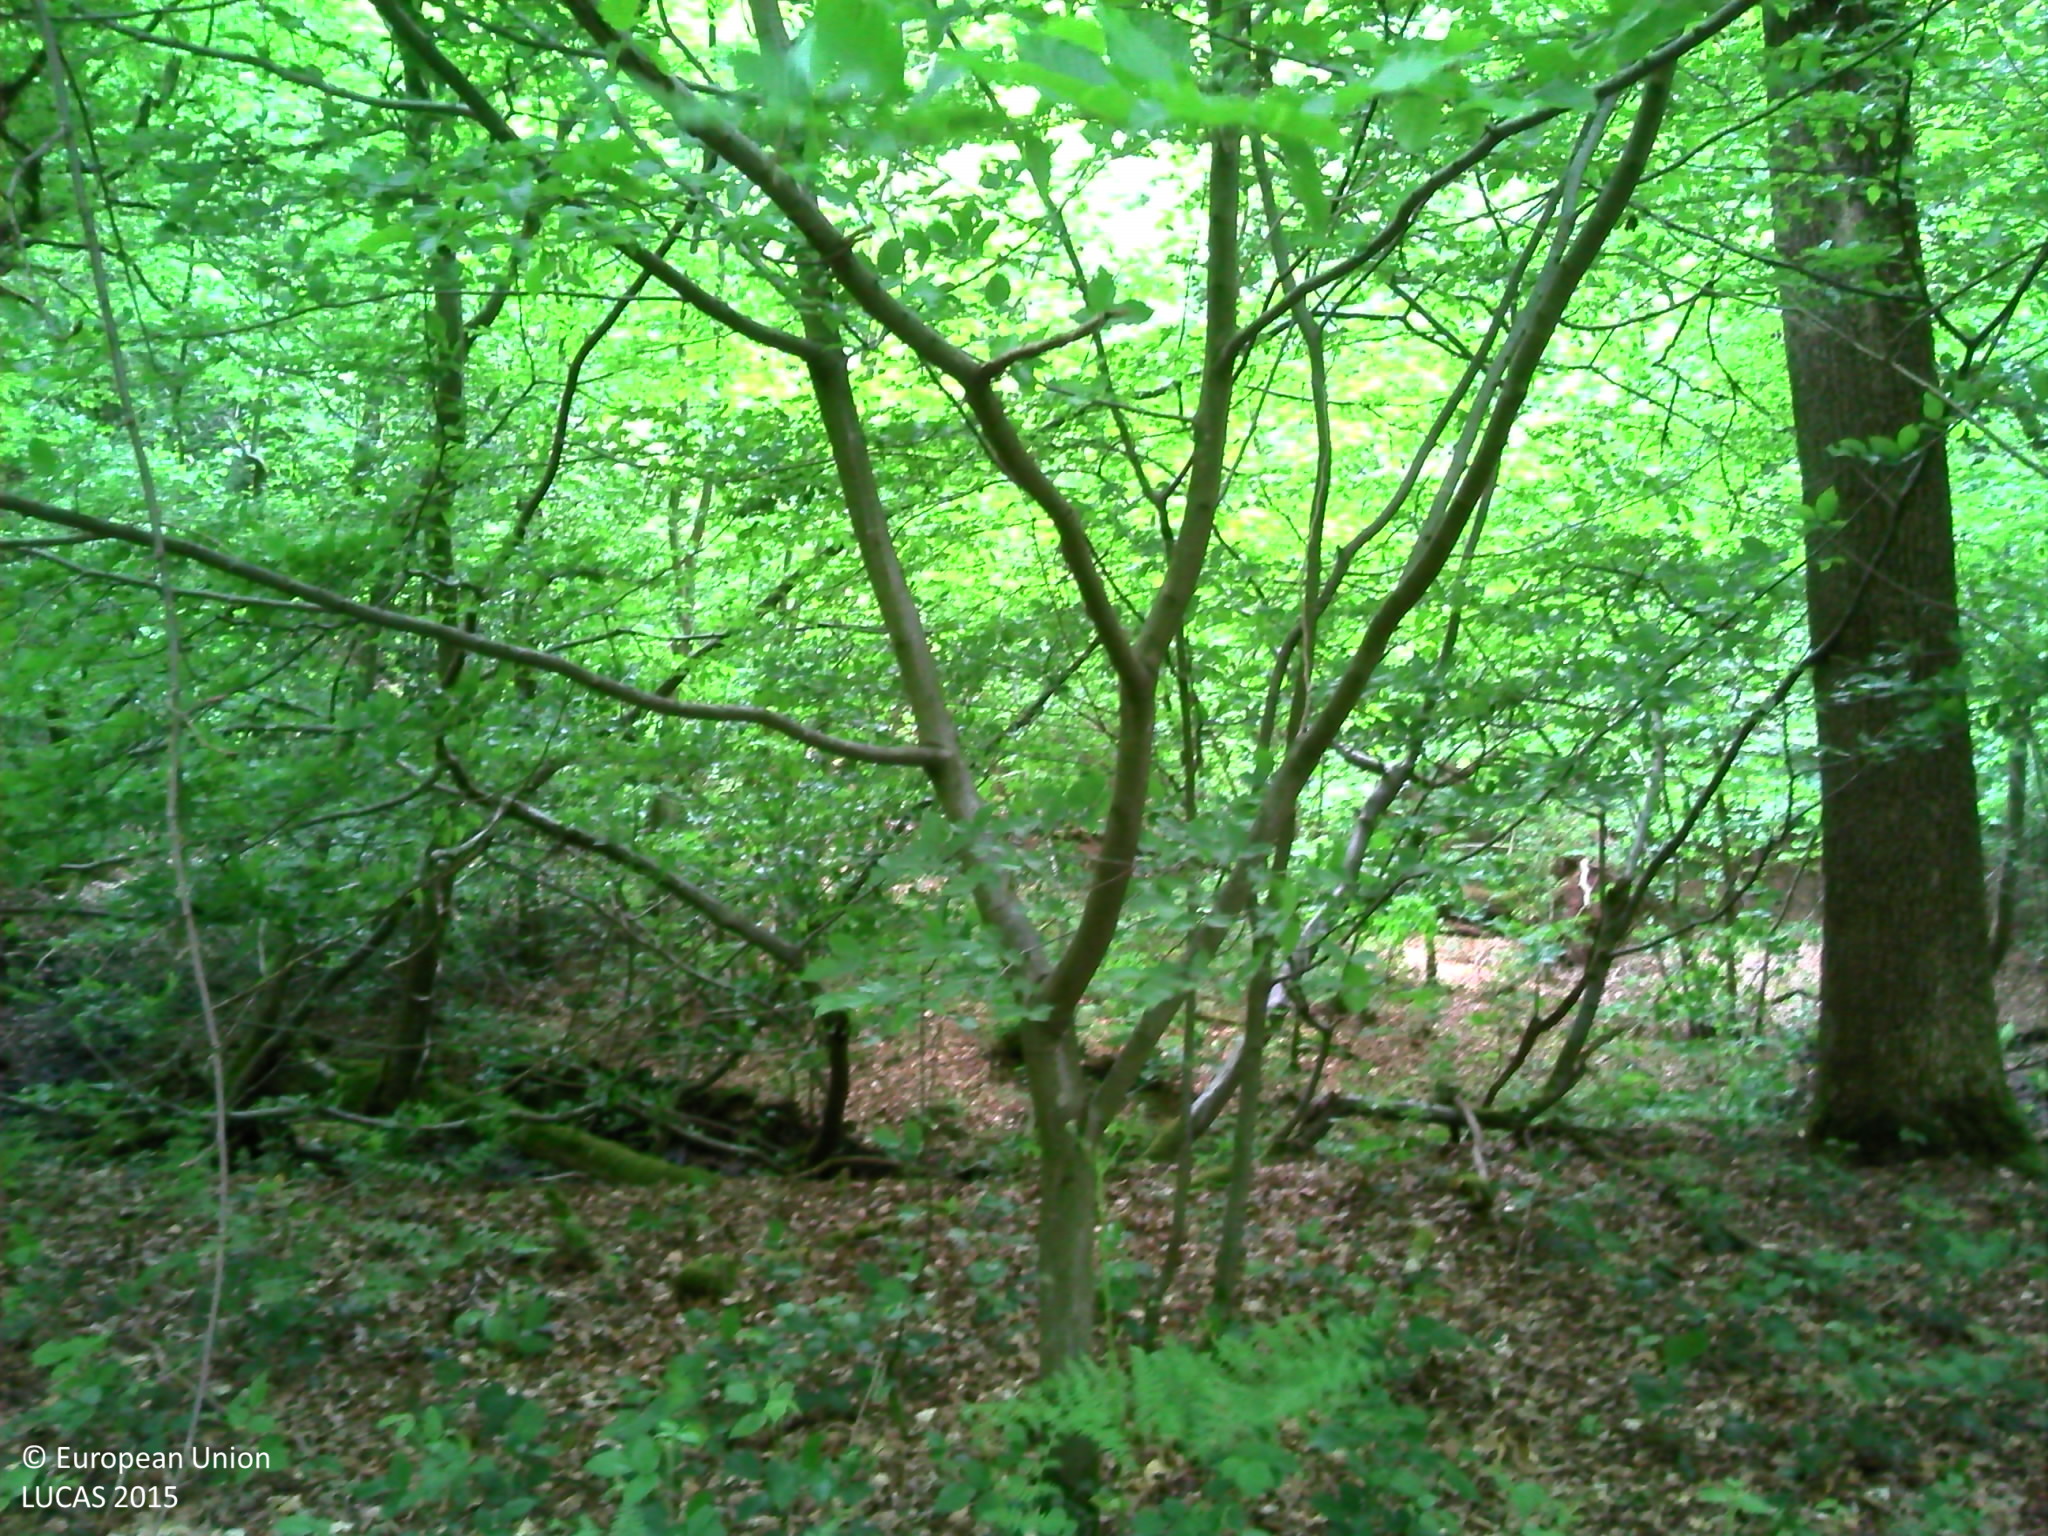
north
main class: Woodland
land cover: Broadleaved woodland
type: mesophytic deciduous forest
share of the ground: > 75 %
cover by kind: broadleaved forest trees 90 %, herbaceous plants 10 %
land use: Forestry
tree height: > 5 m
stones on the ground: < 10 %
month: June
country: BE
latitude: 50.4243
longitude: 5.6209
